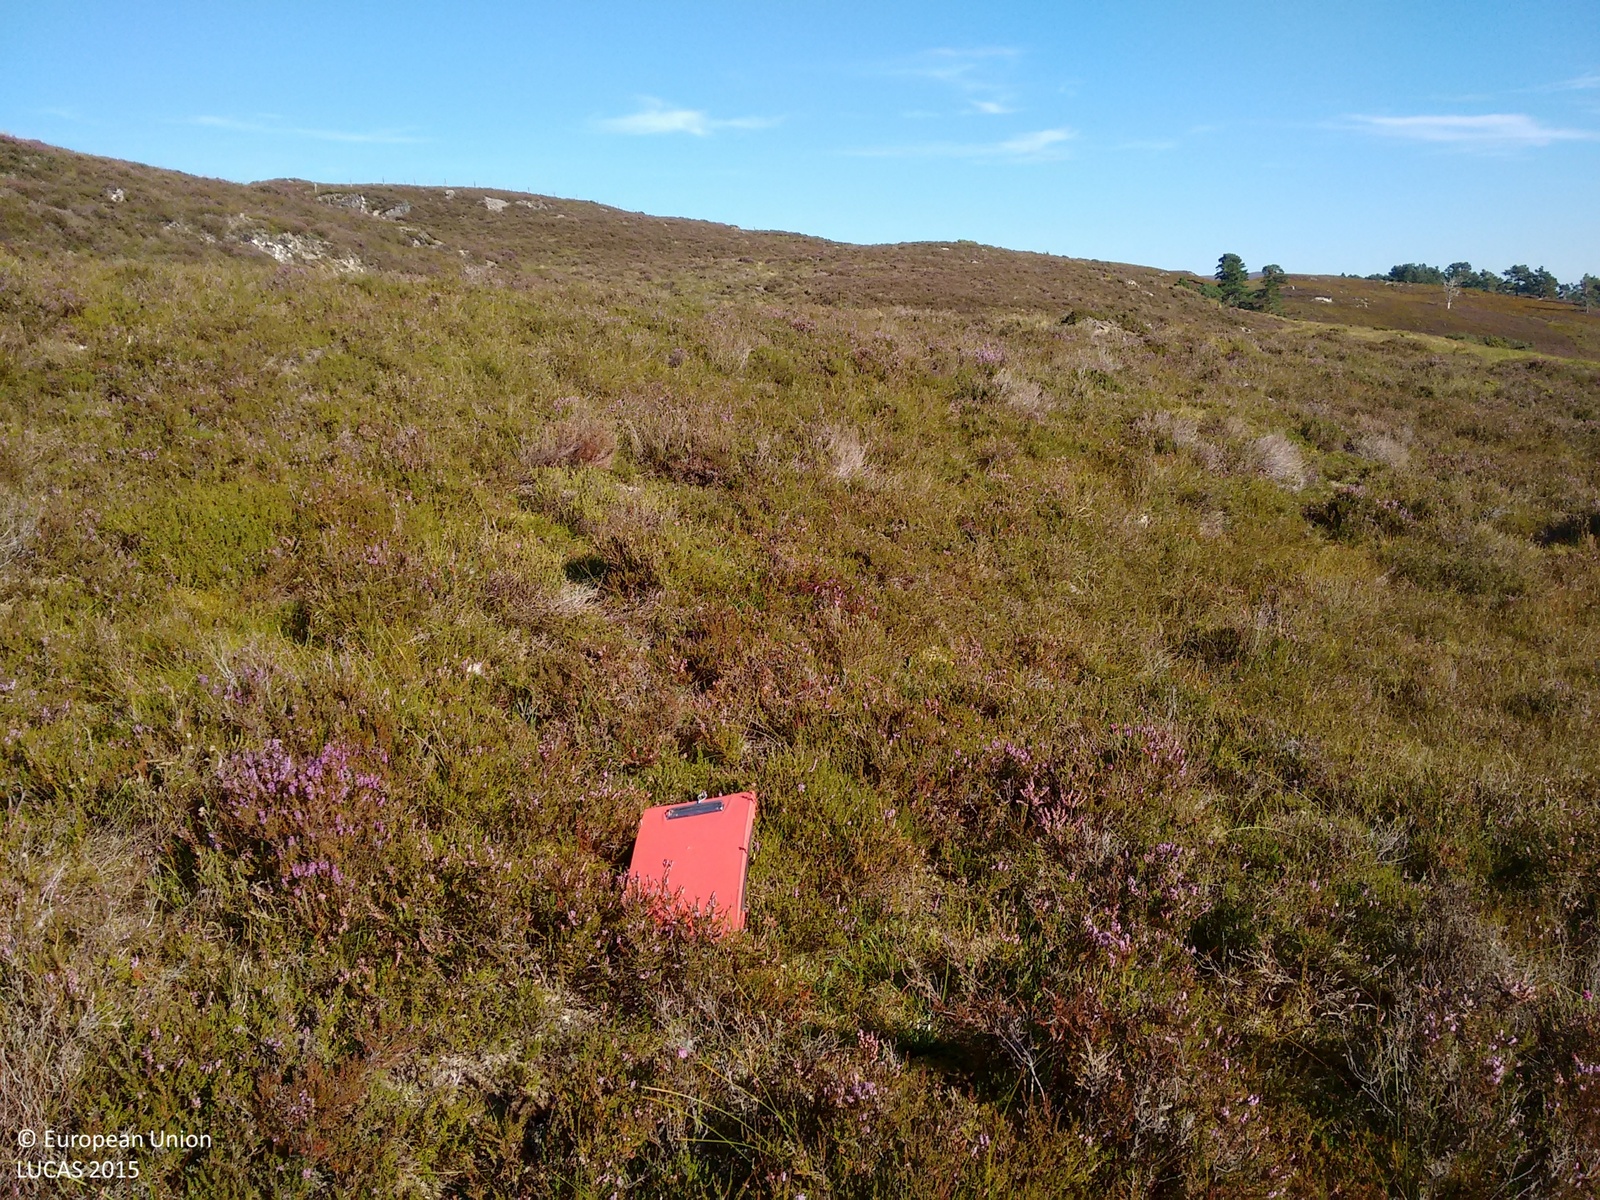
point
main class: Shrubland
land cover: Shrubland without tree cover
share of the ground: > 75 %
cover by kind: shrubs 100 %
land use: Agriculture (excluding fallow land and kitchen gardens)
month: September
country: GB
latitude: 57.9199
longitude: -4.3503
